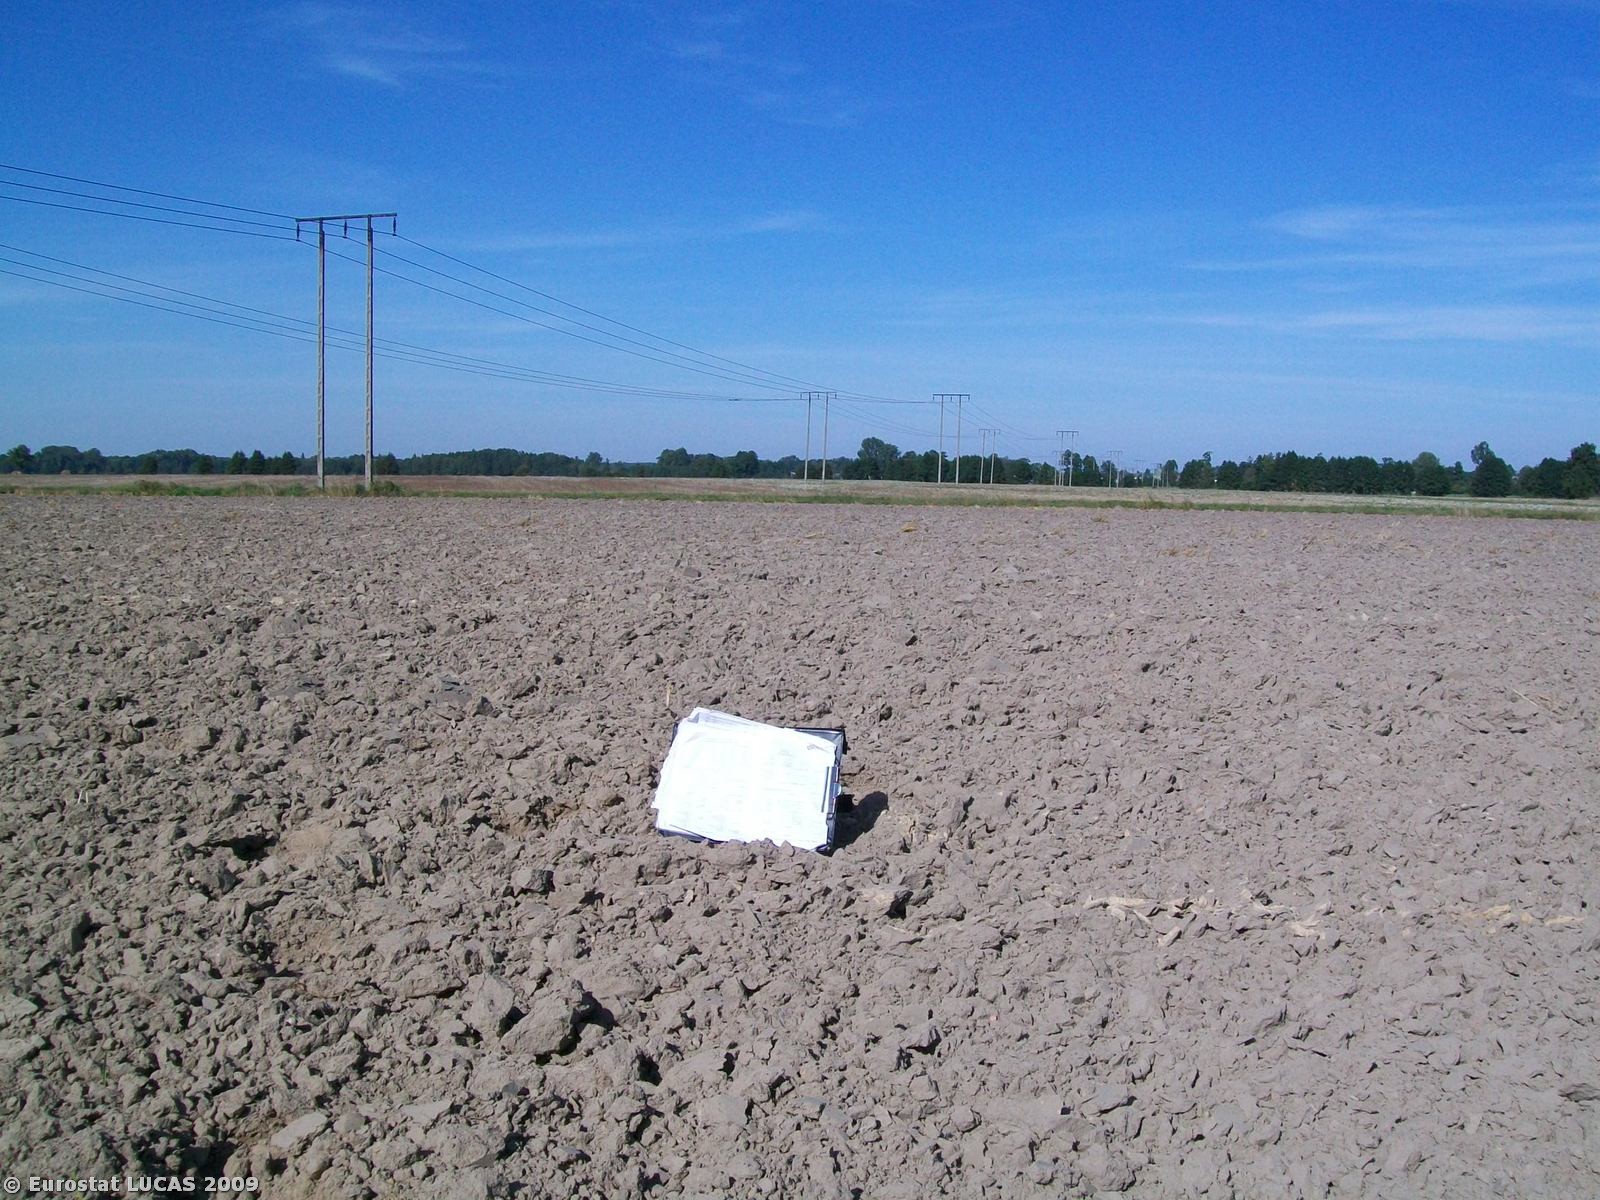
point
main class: Cropland
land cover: Oats
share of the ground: < 10 %
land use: Agriculture (excluding fallow land and kitchen gardens)
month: September
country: PL
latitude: 51.2959
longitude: 17.9752
